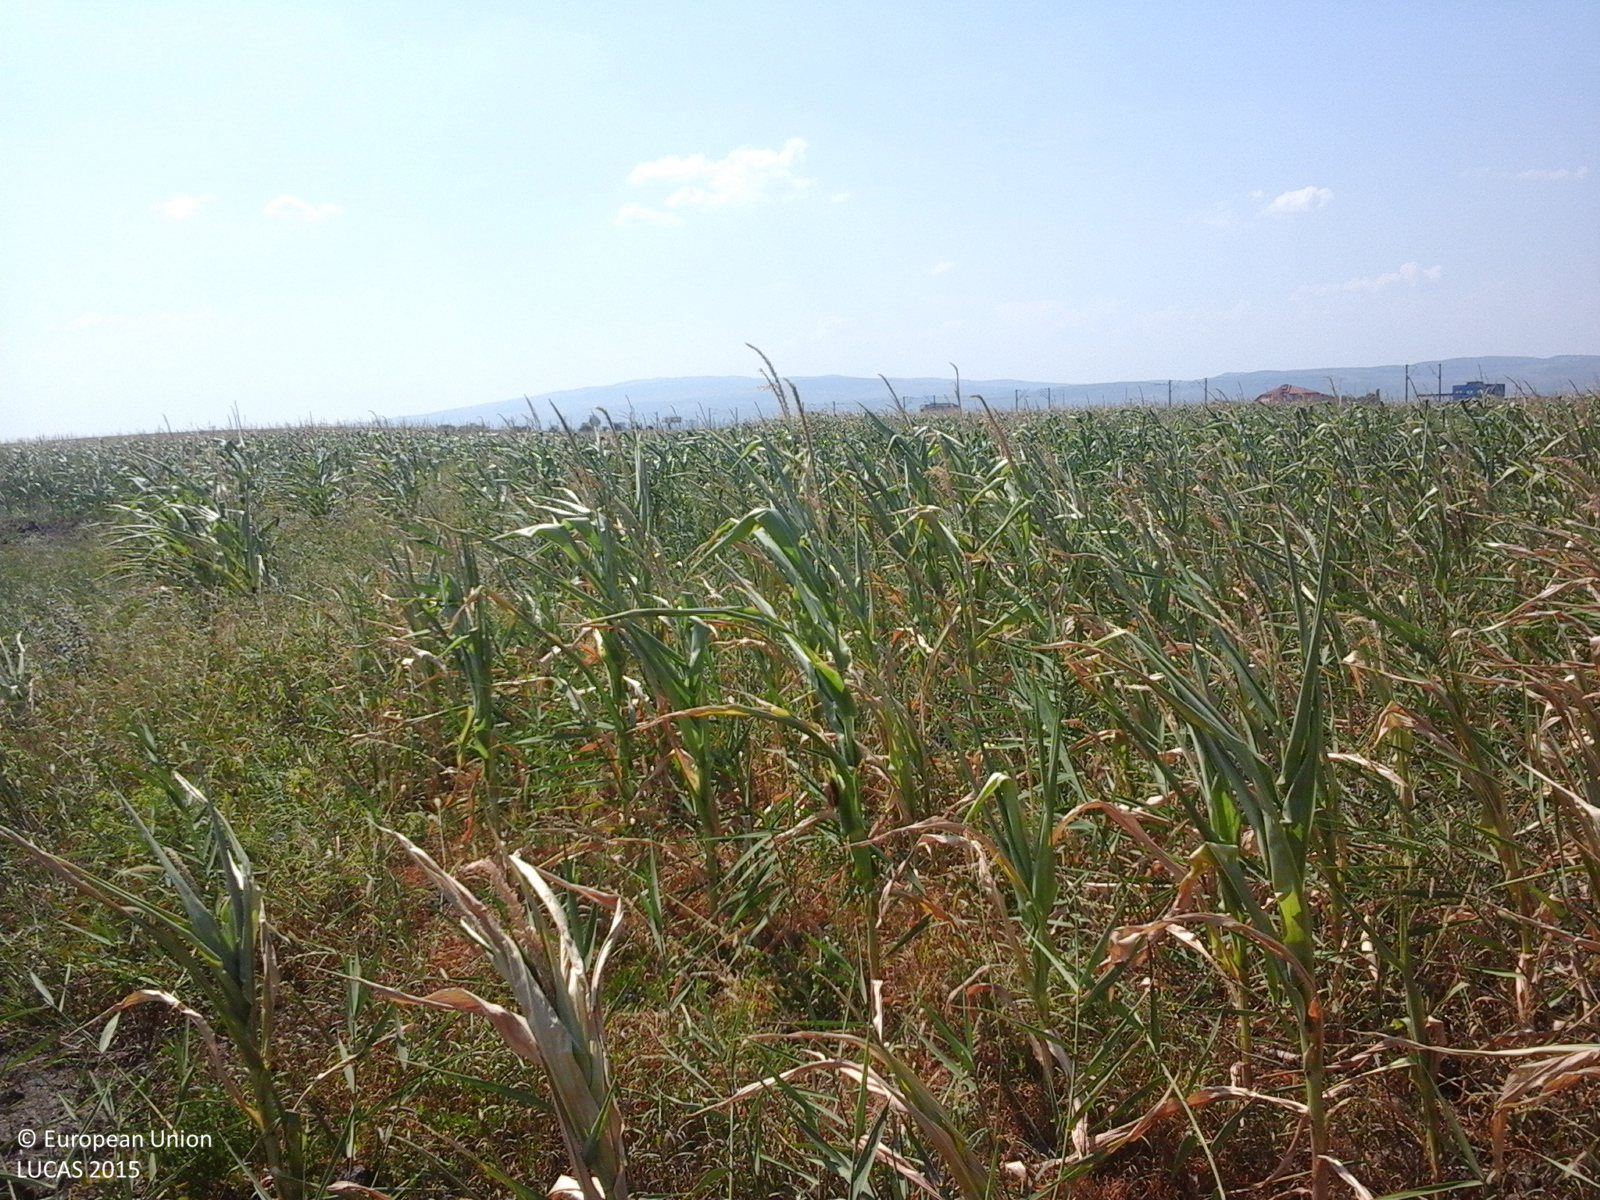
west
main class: Cropland
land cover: Maize
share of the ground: > 75 %
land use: Agriculture (excluding fallow land and kitchen gardens)
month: August
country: RO
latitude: 45.1251
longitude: 26.7712
